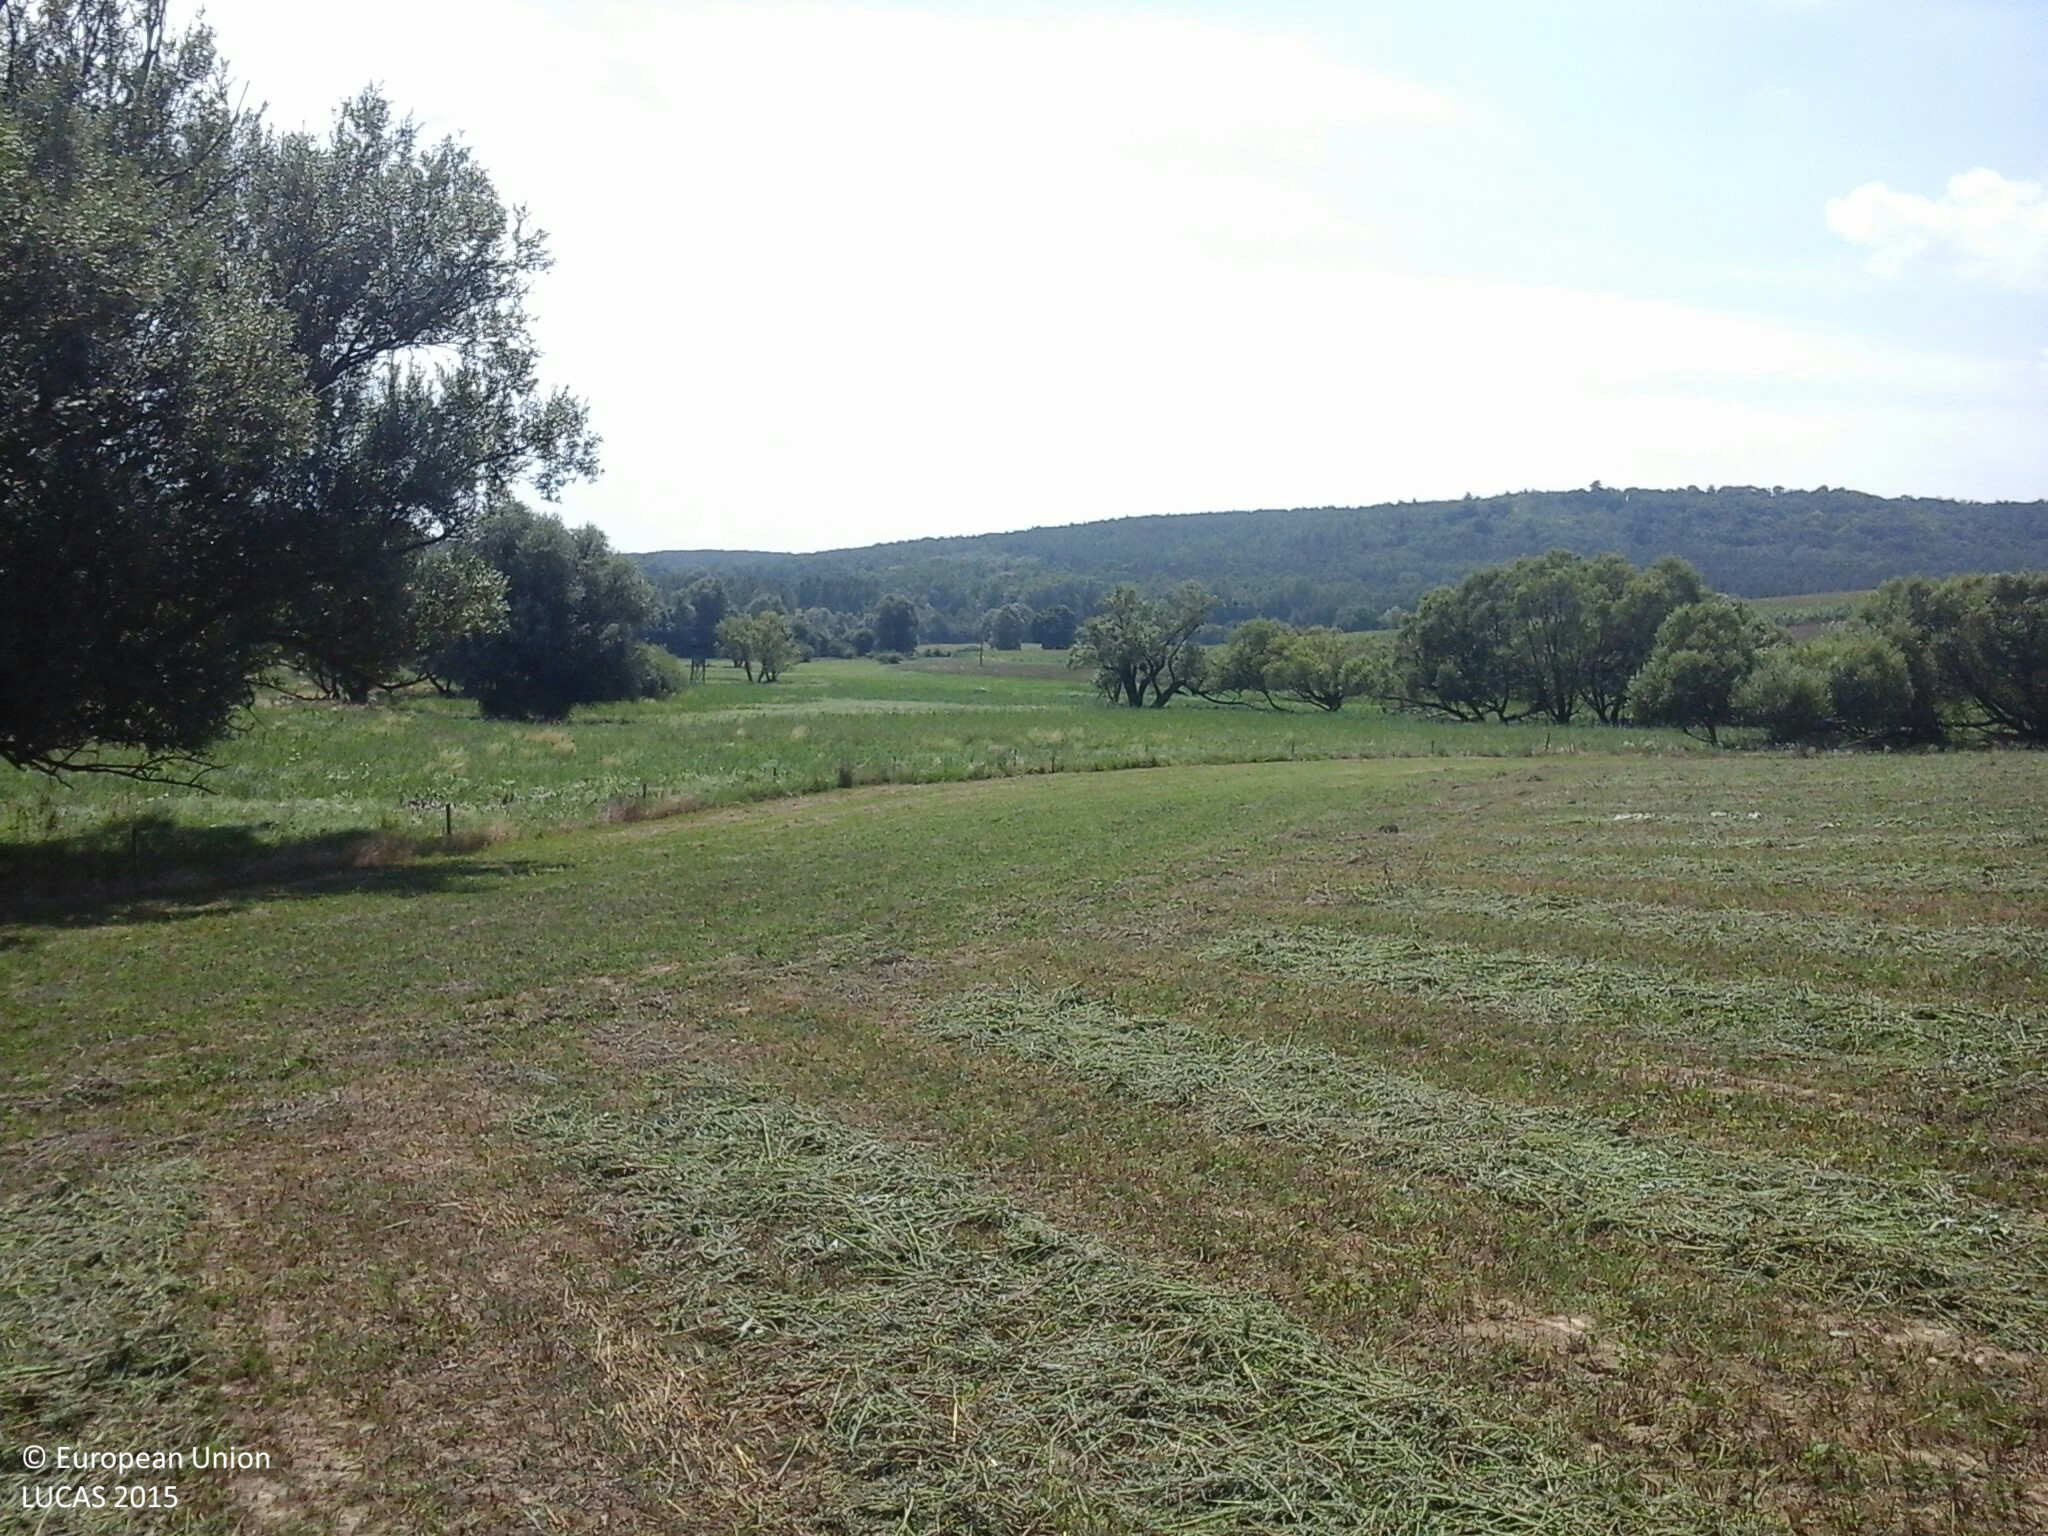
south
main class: Cropland
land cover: Lucerne
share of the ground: 25 - 50 %
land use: Agriculture (excluding fallow land and kitchen gardens)
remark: Harvested field
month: August
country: HU
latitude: 46.7206
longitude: 18.0020
